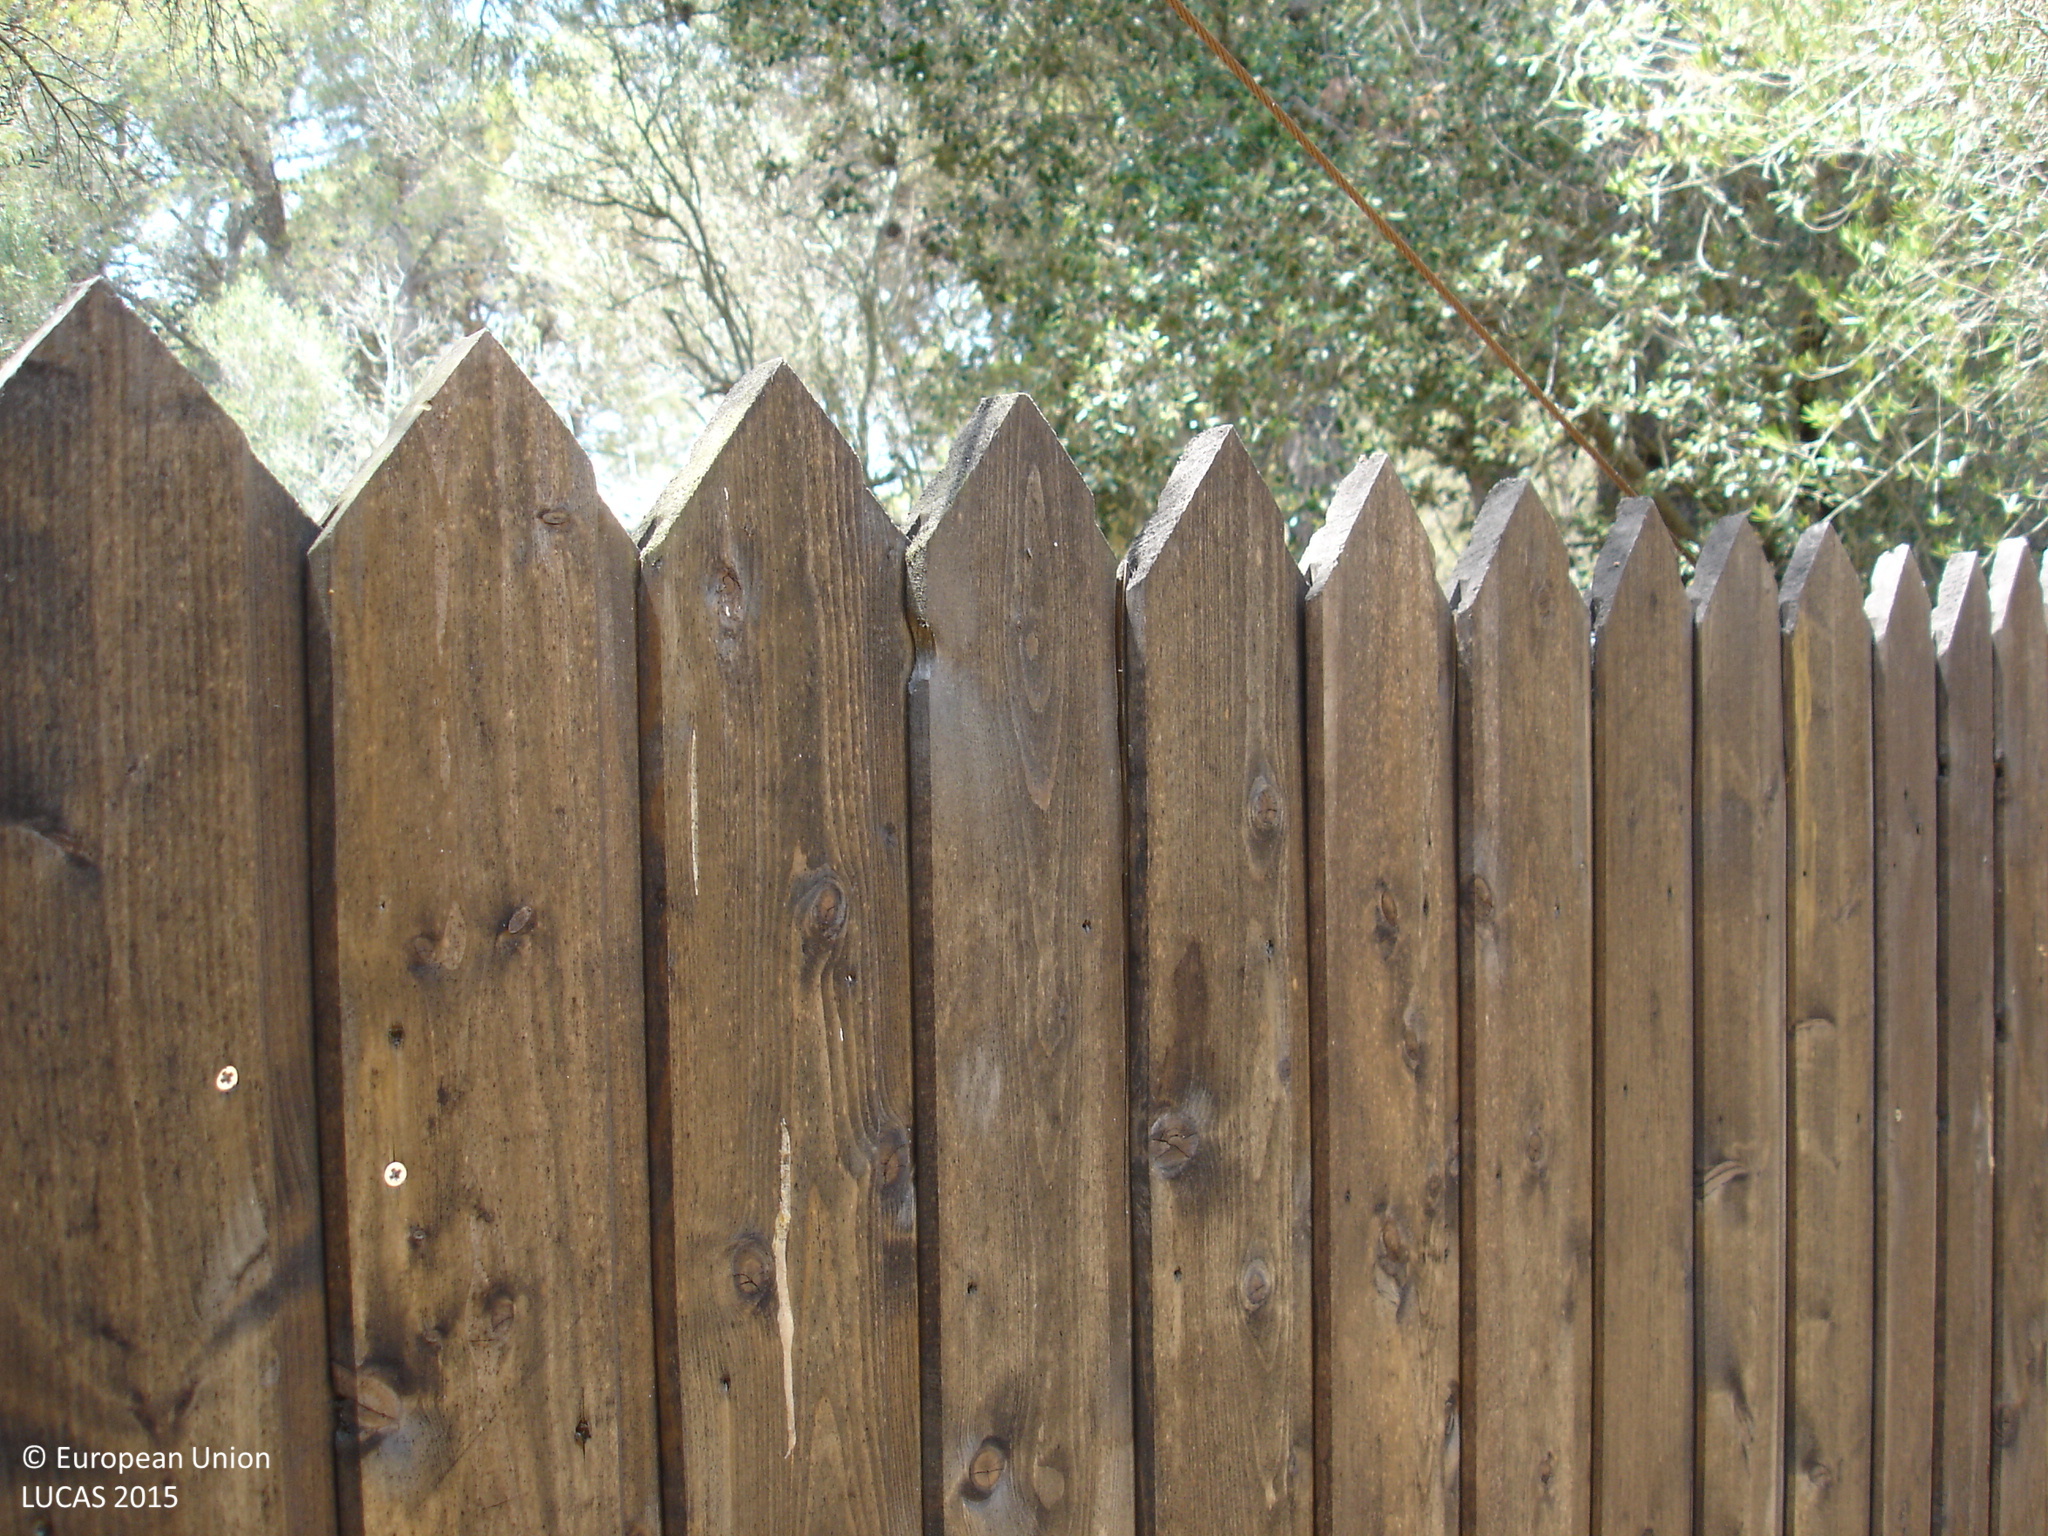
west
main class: Woodland
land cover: Other mixed woodland
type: thermophilous deciduous forest
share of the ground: > 75 %
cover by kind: broadleaved forest trees 50 %, coniferous forest trees 30 %, herbaceous plants 20 %
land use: Forestry
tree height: > 5 m
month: July
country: ES
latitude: 41.8577
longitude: 3.1142
